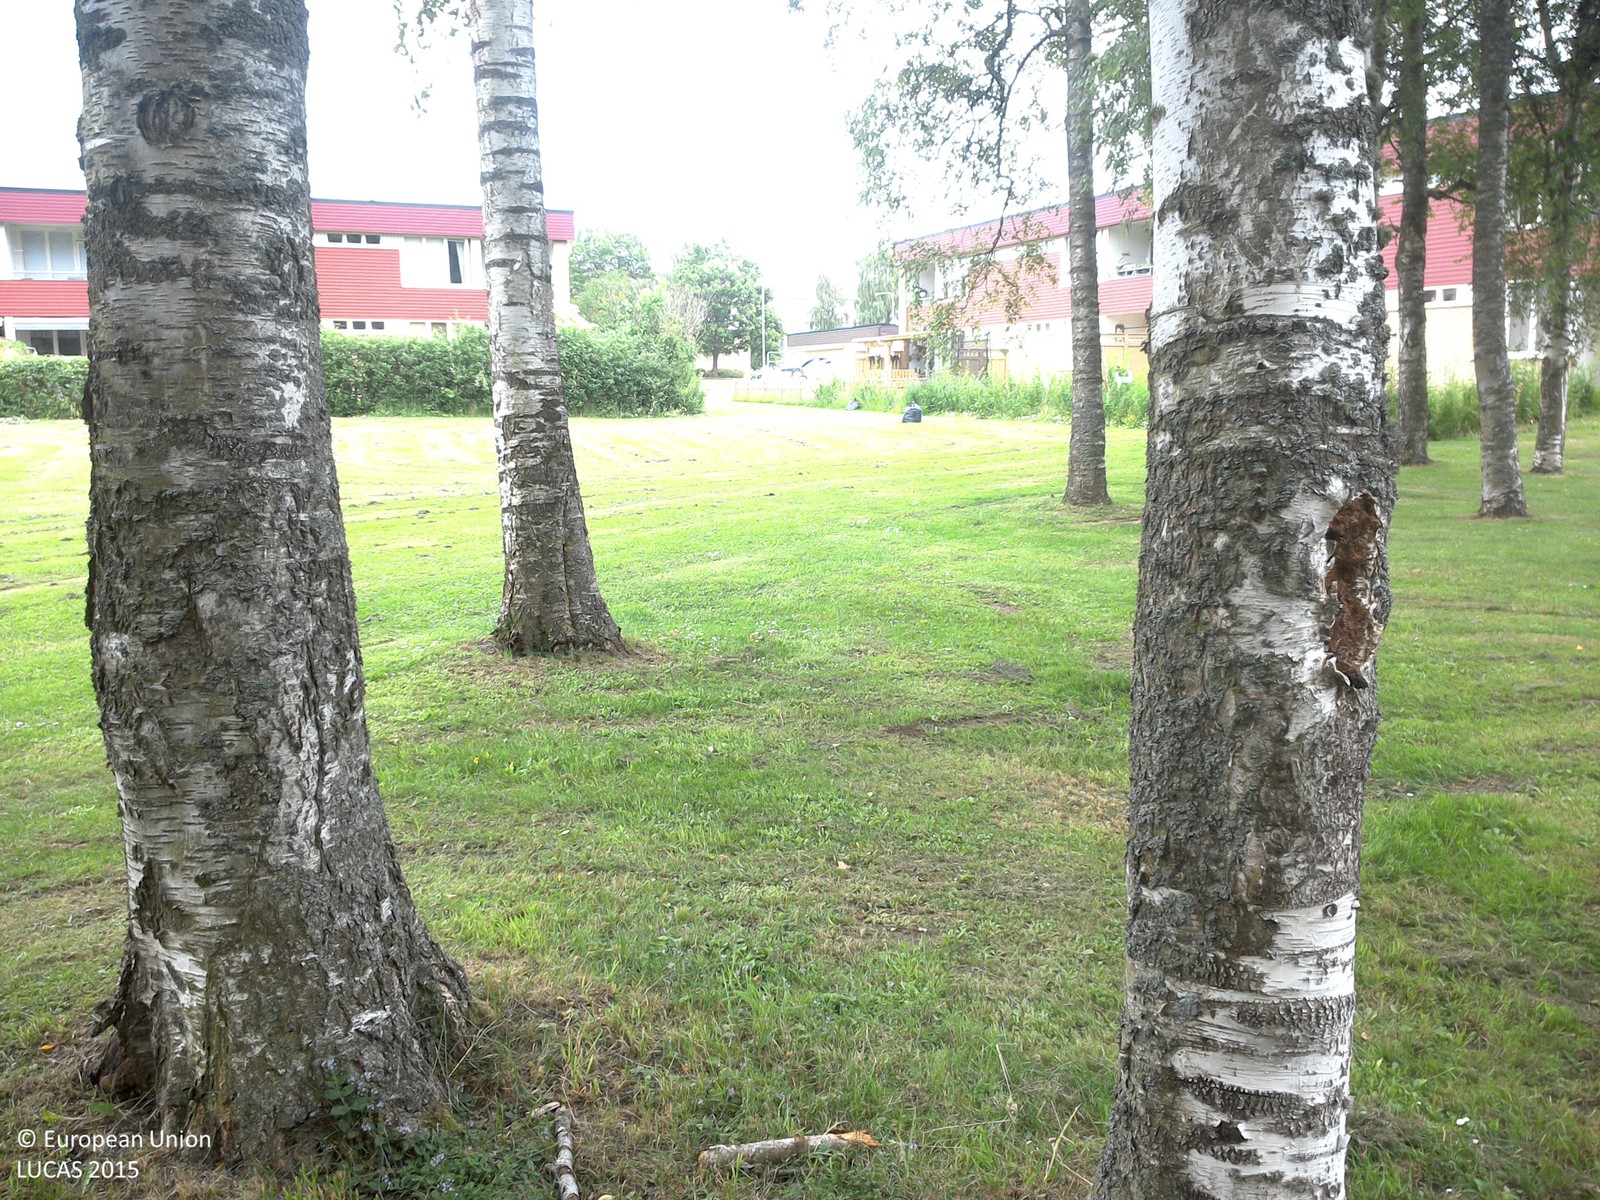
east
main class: Woodland
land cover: Broadleaved woodland
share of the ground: < 10 %
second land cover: Grassland without tree/shrub cover
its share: > 75 %
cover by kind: herbaceous plants 75 %, broadleaved forest trees 25 %
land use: Amenities, museums, leisure
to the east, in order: Broadleaved woodland; Grassland without tree/shrub cover; Artificial constructions in urban areas
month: June
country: SE
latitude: 58.4113
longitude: 15.5572
